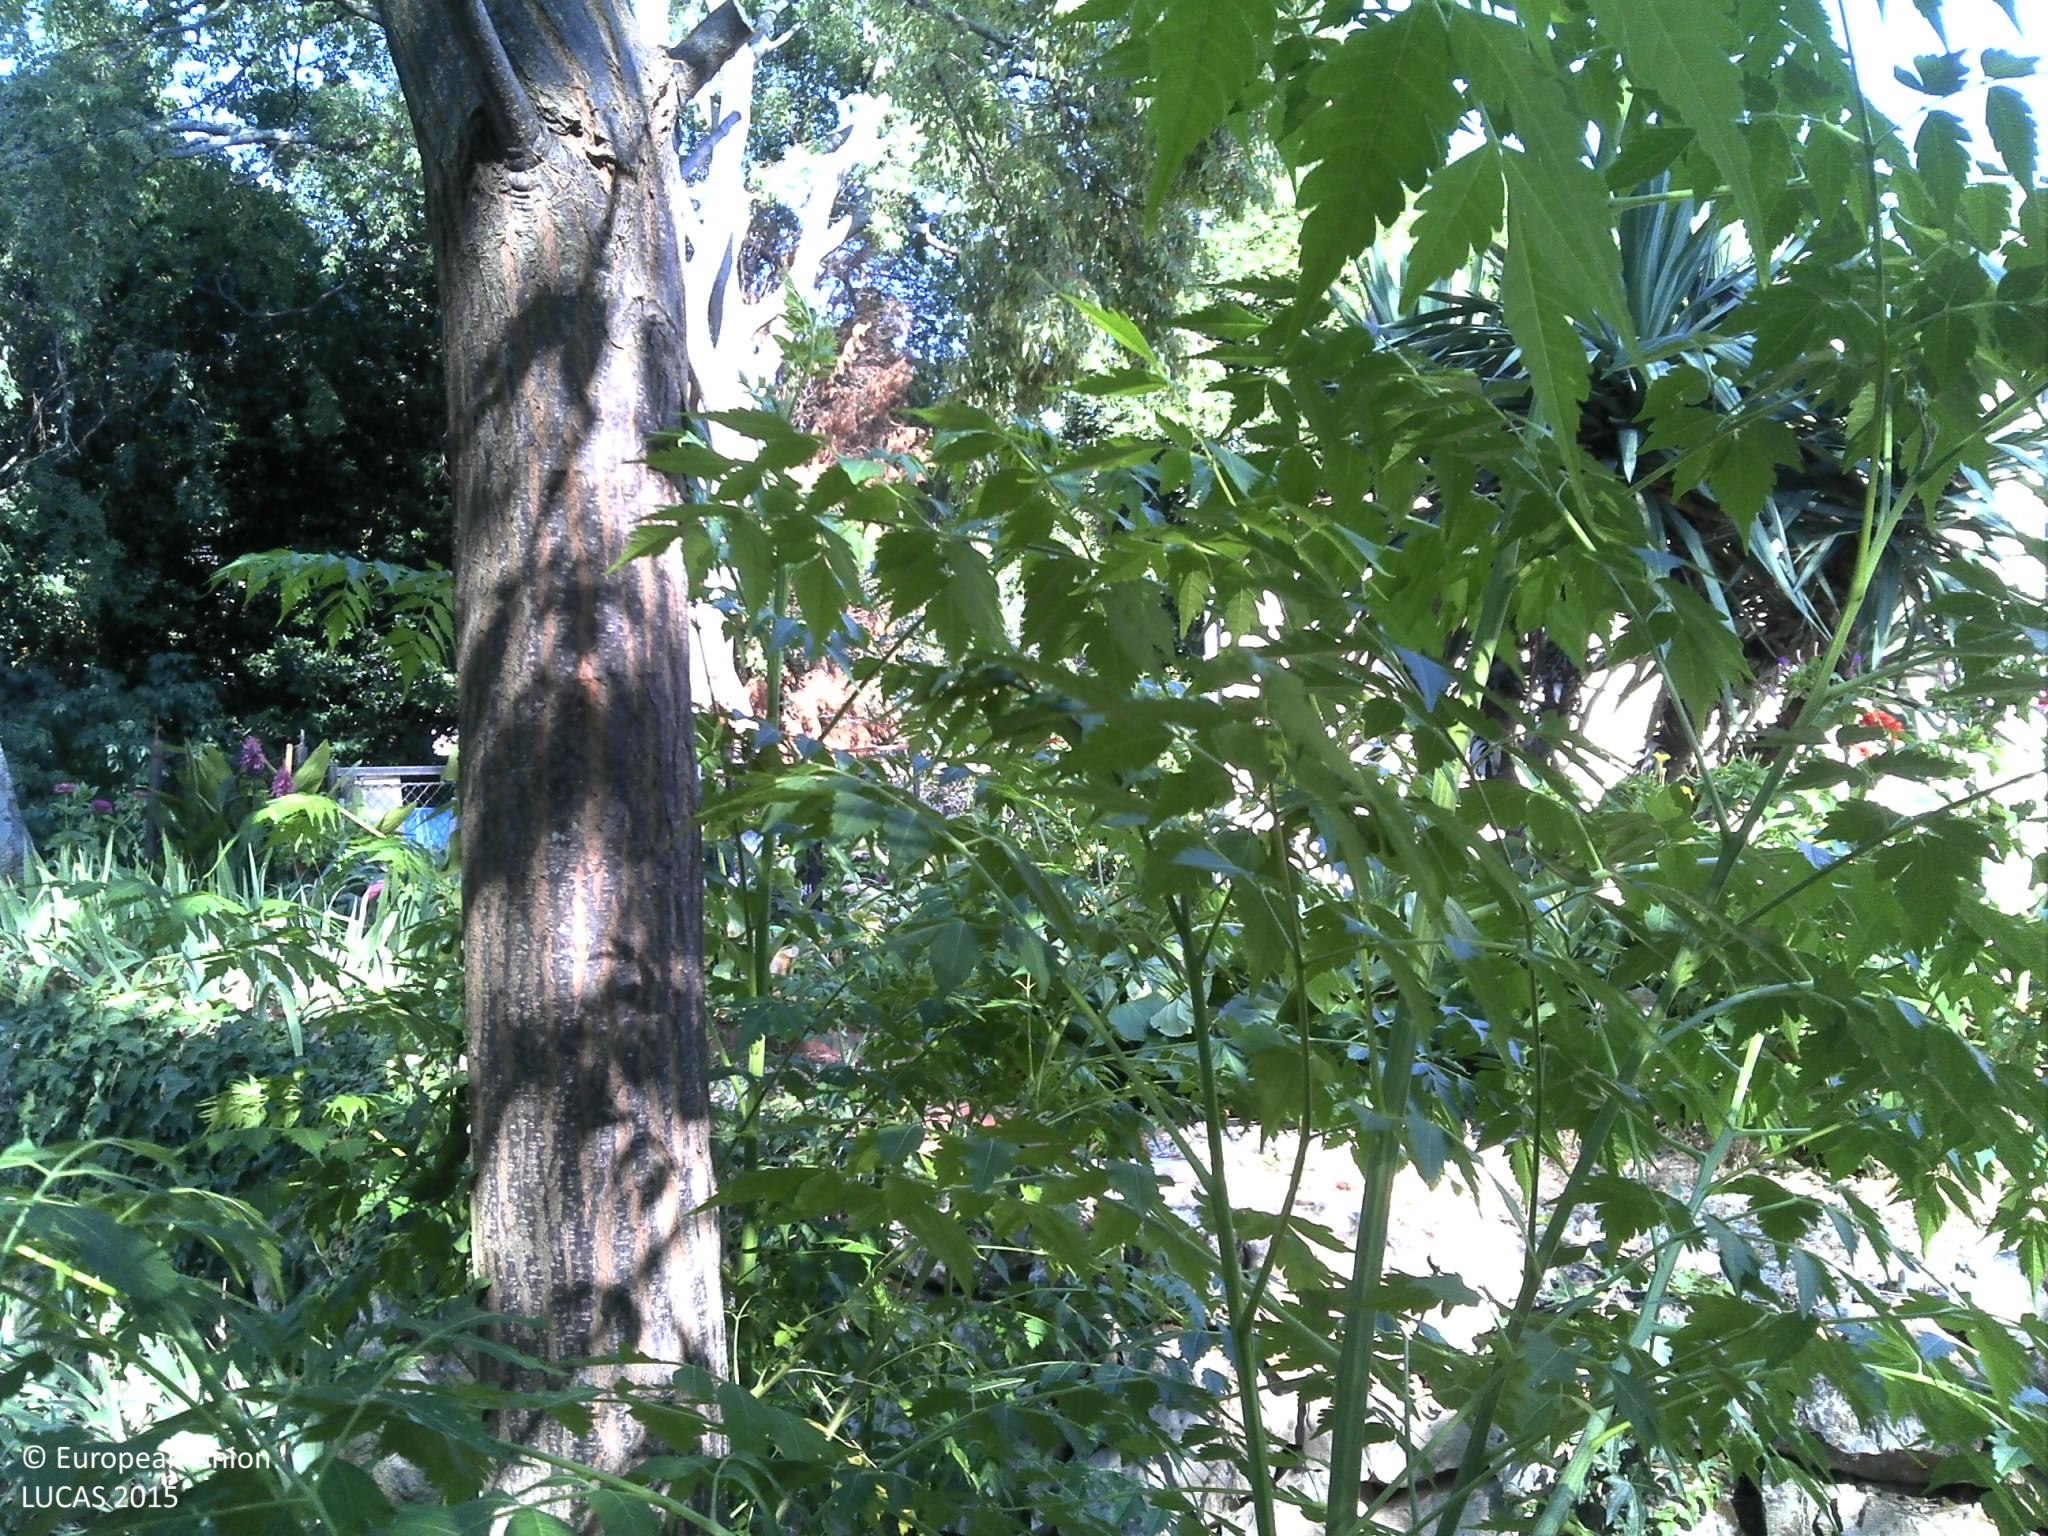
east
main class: Woodland
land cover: Broadleaved woodland
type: thermophilous deciduous forest
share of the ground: 50 - 75 %
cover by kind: broadleaved forest trees 55 %, herbaceous plants 15 %, coniferous forest trees 10 %, consolidated bare surface 10 %, lichens and mosses 5 %, unconsolidated bare surface 5 %
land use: Amenities, museums, leisure
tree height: > 5 m
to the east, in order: Broadleaved woodland; Artificial constructions in urban areas; Broadleaved woodland; Artificial constructions in urban areas
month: July
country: HR
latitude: 42.6575
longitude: 18.0783
